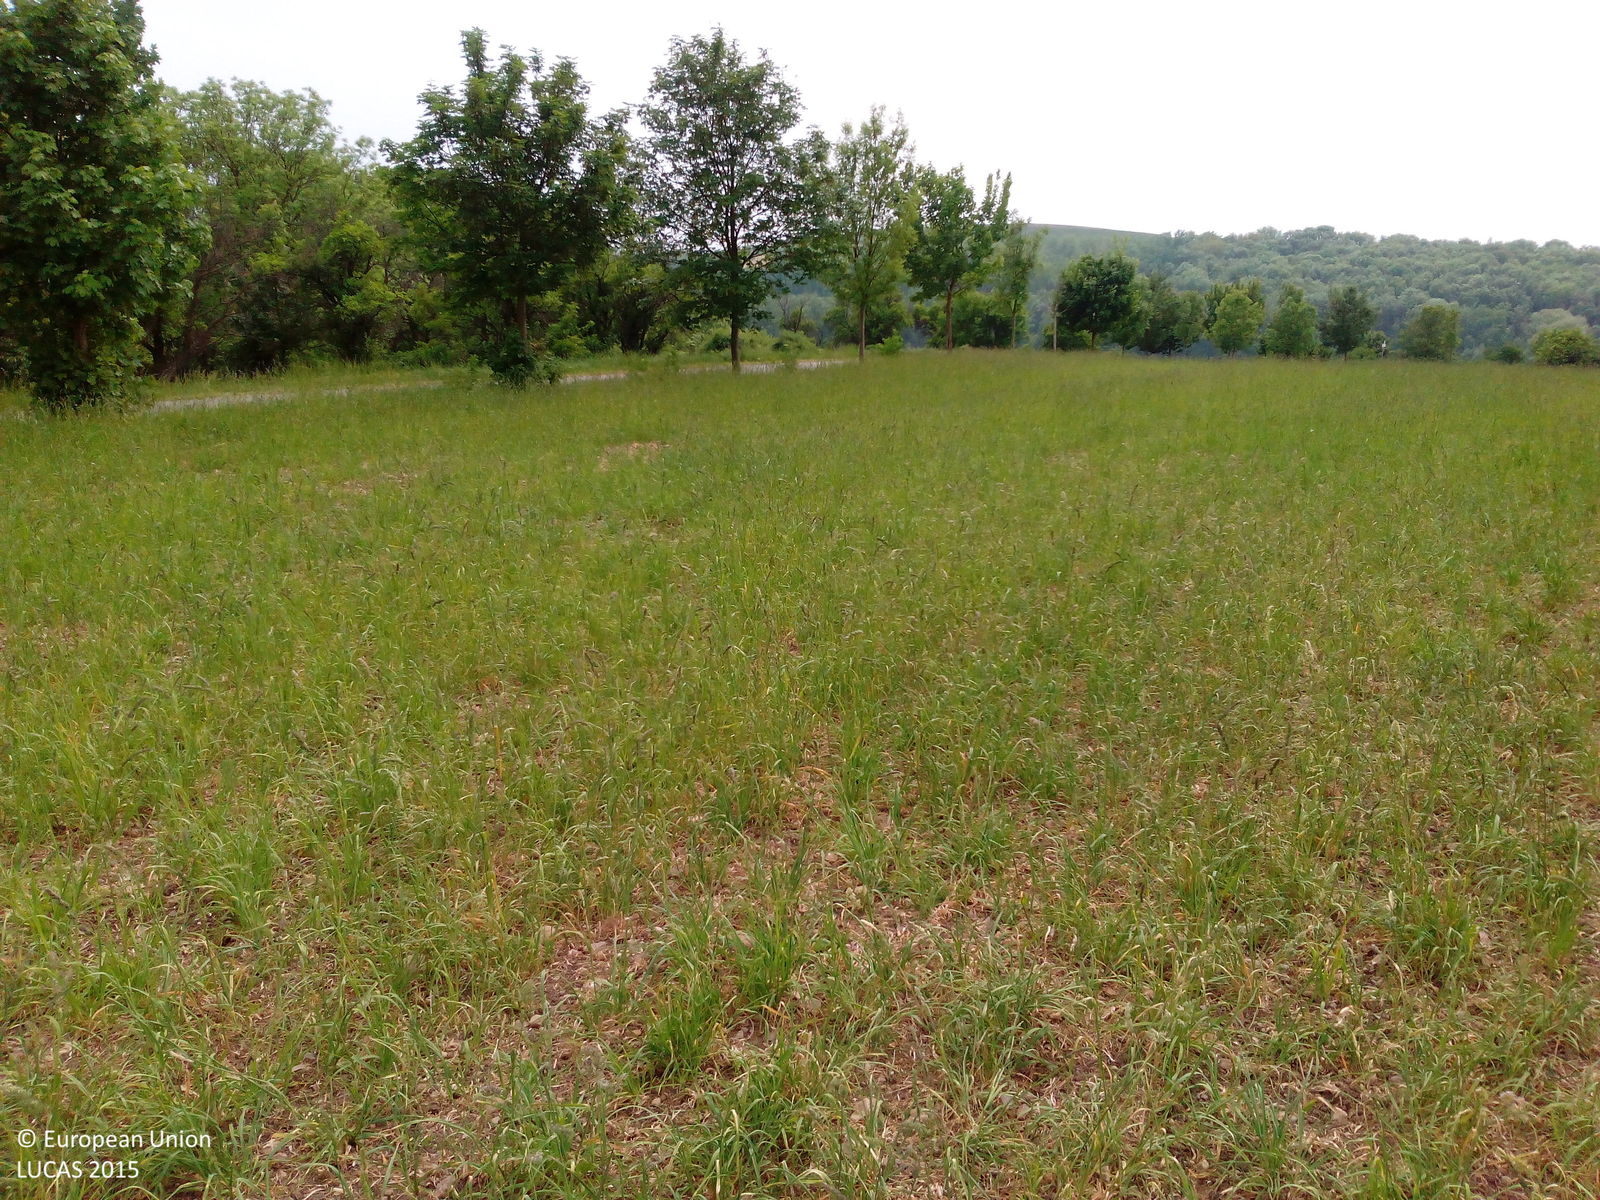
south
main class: Cropland
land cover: Temporary grasslands
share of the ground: > 75 %
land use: Agriculture (excluding fallow land and kitchen gardens)
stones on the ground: 25 - 50 %
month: May
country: DE
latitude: 51.0552
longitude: 11.5262
